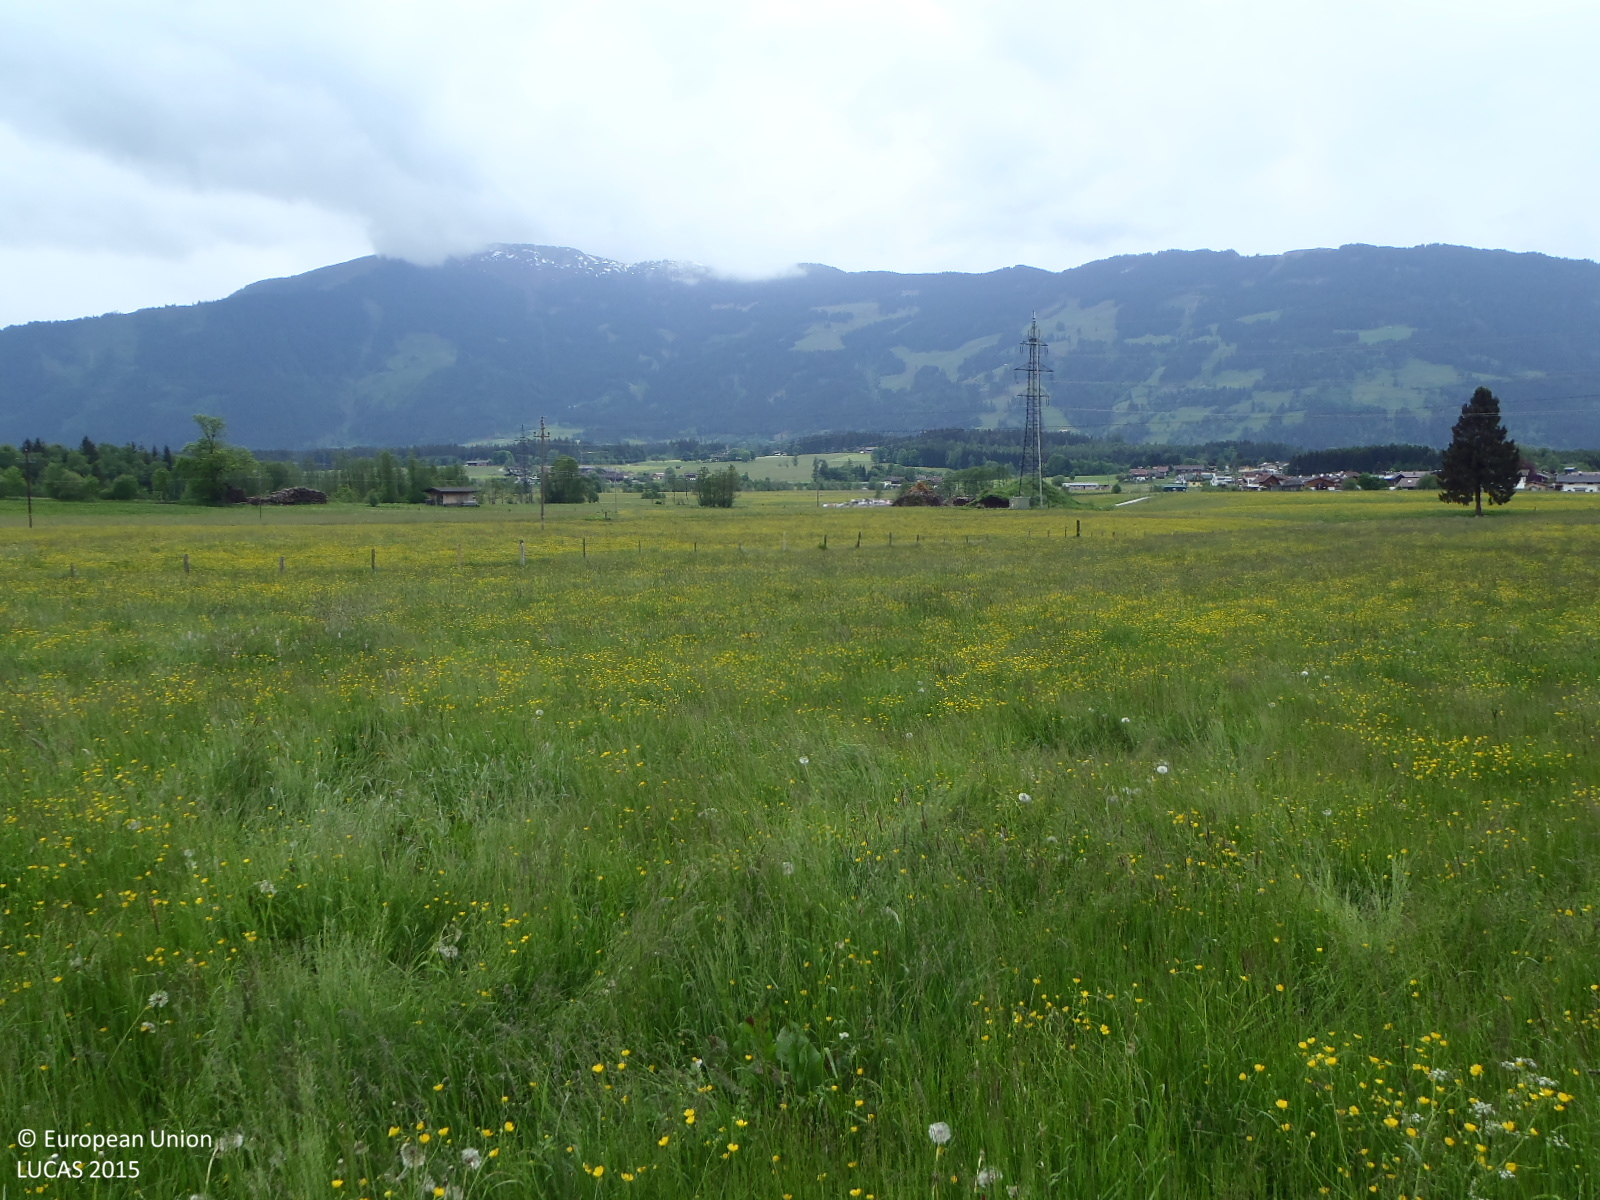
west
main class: Grassland
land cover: Grassland without tree/shrub cover
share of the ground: > 75 %
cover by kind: herbaceous plants 100 %
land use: Agriculture (excluding fallow land and kitchen gardens)
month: May
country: AT
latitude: 47.3944
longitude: 12.8466
